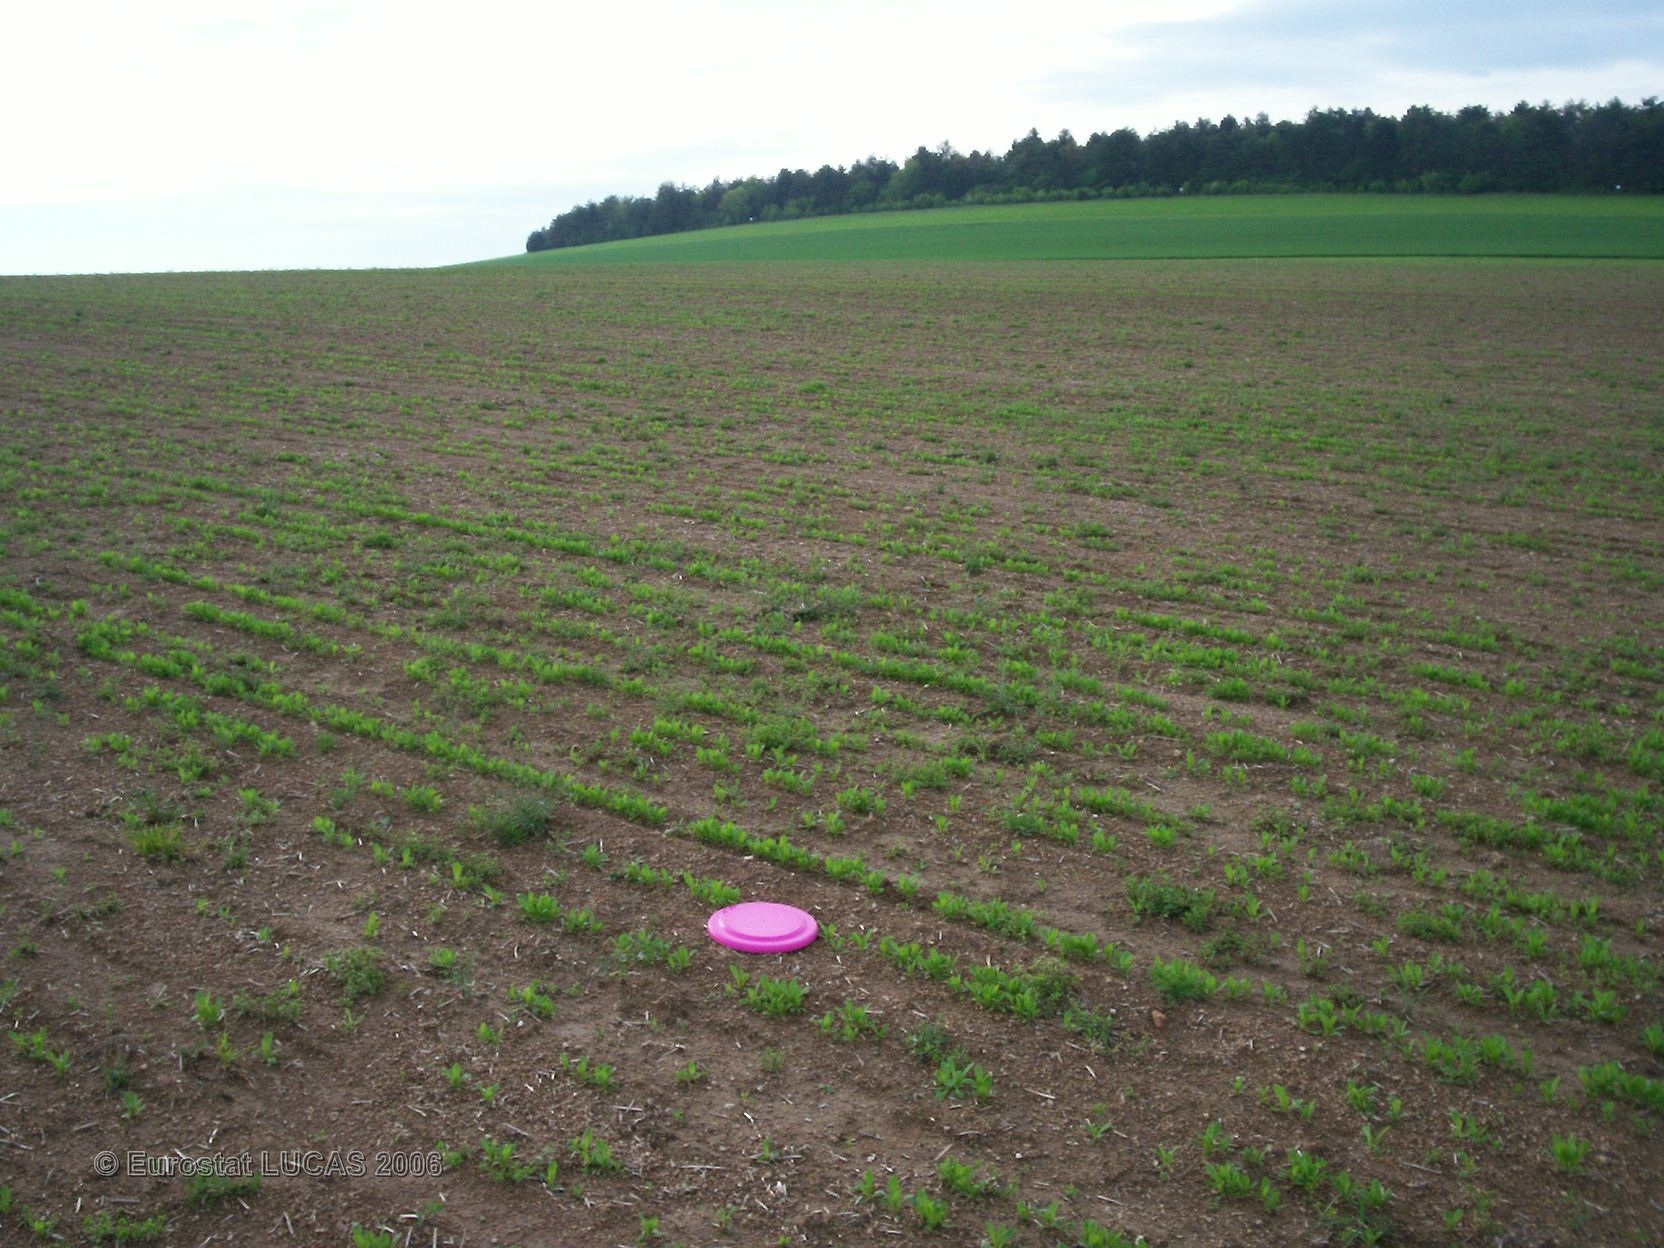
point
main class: Cropland
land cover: Other fibre and oleaginous crops
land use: Agriculture (excluding fallow land and kitchen gardens)
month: May
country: FR
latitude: 49.2150
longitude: 4.3538
